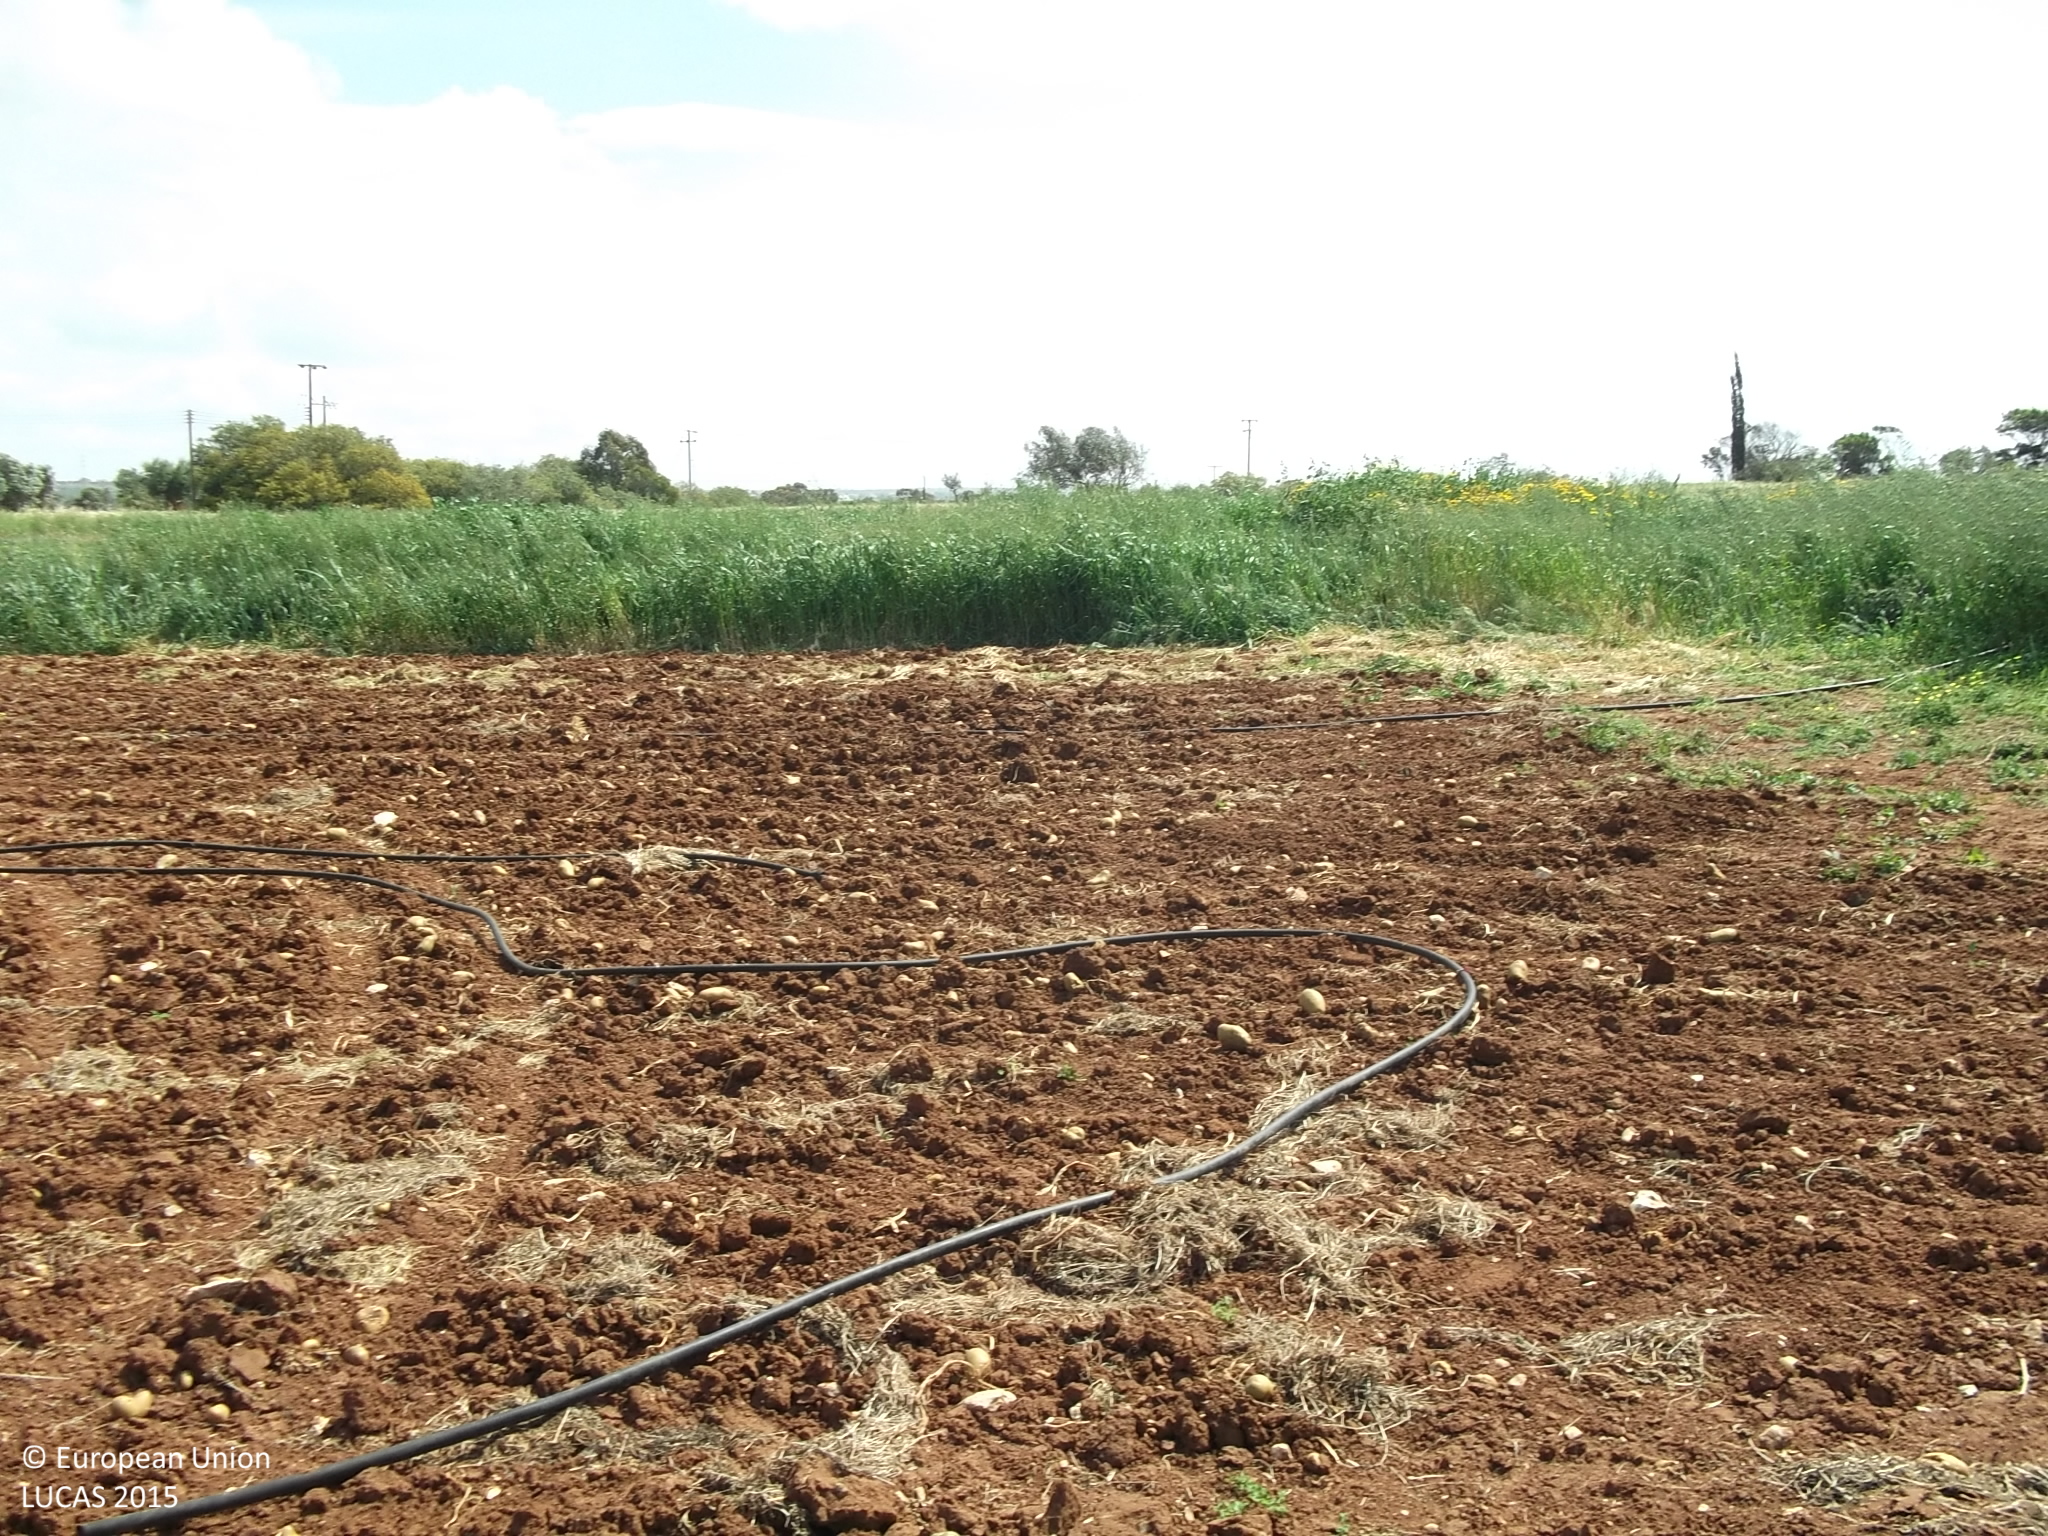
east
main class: Cropland
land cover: Potatoes
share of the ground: < 10 %
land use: Agriculture (excluding fallow land and kitchen gardens)
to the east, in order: Potatoes; Spontaneously vegetated surfaces; Olive groves; Common wheat; Grass margins; Tracks; Broadleaved woodland; Electric lines; Tracks; Shrubland without tree cover; Grassland without tree/shrub cover
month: March
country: CY
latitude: 34.9953
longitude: 33.9549
